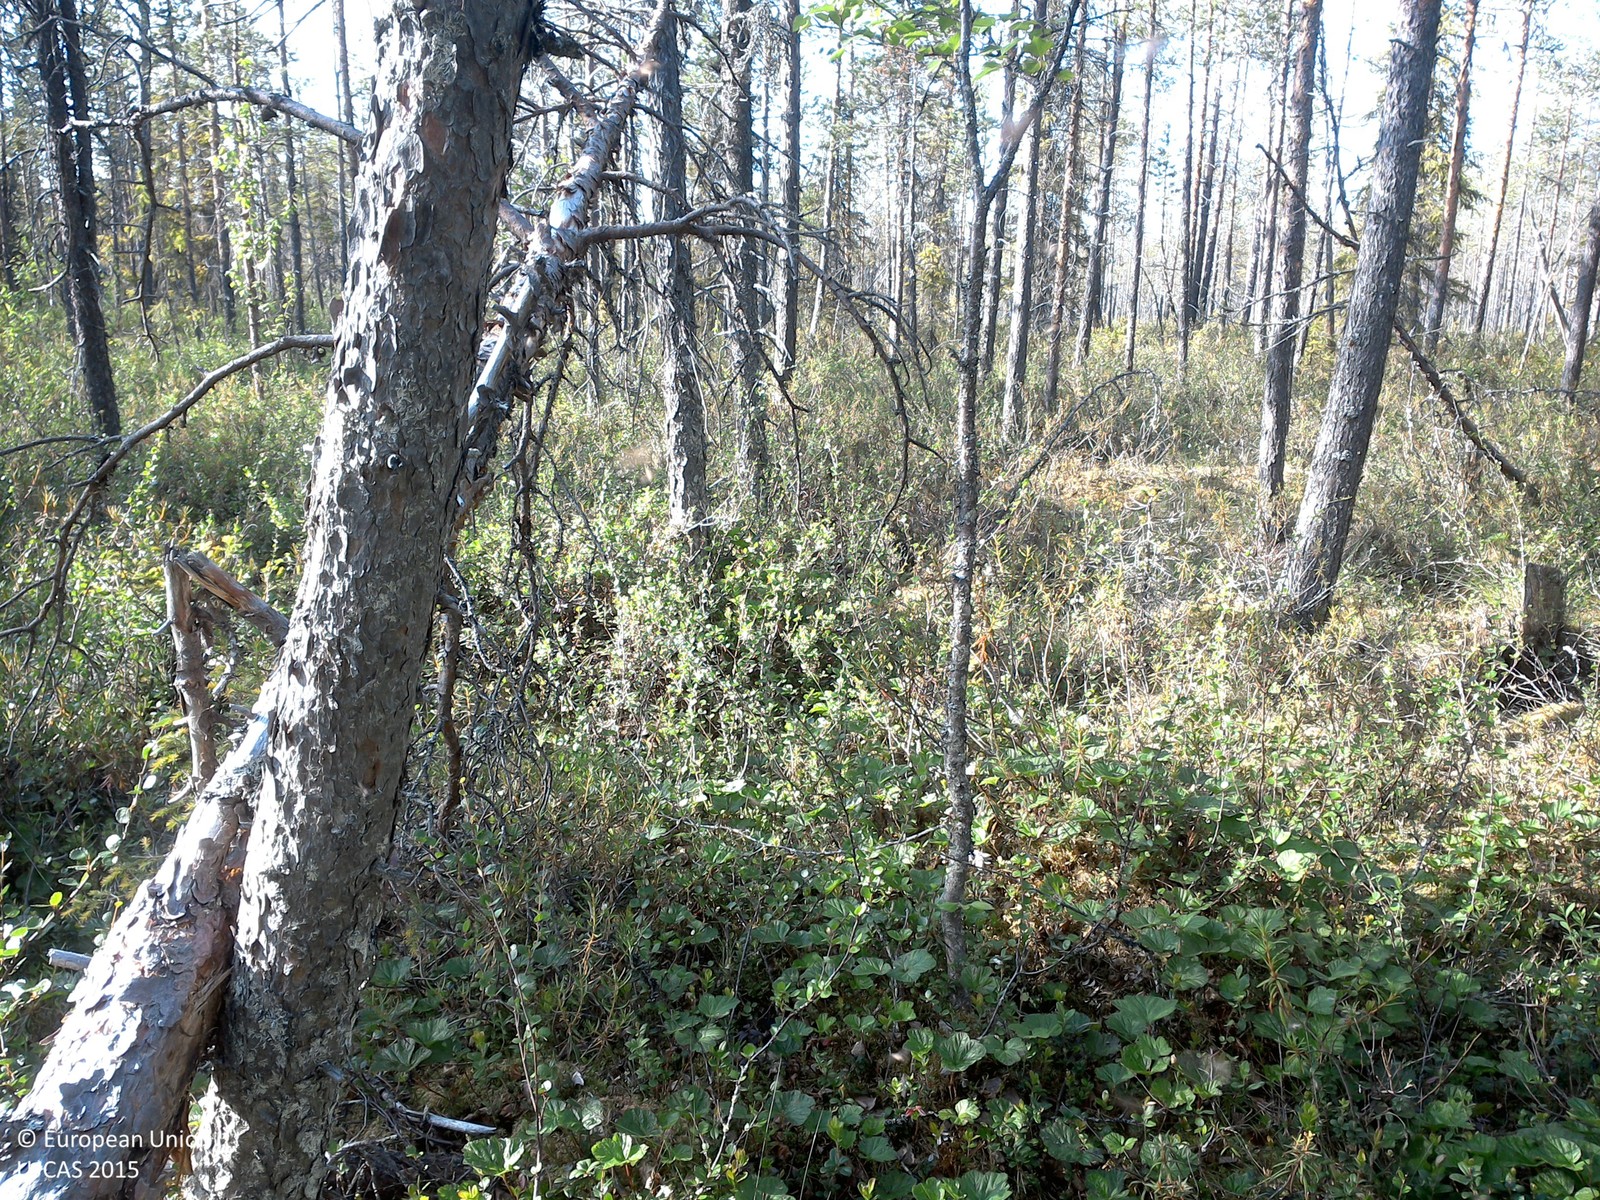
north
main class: Woodland
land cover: Pine dominated mixed woodland
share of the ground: 10 - 25 %
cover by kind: shrubs 45 %, herbaceous plants 20 %, coniferous forest trees 15 %, lichens and mosses 15 %, broadleaved forest trees 5 %
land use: Forestry
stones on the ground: < 10 %
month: July
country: SE
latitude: 67.2667
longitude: 22.6938
